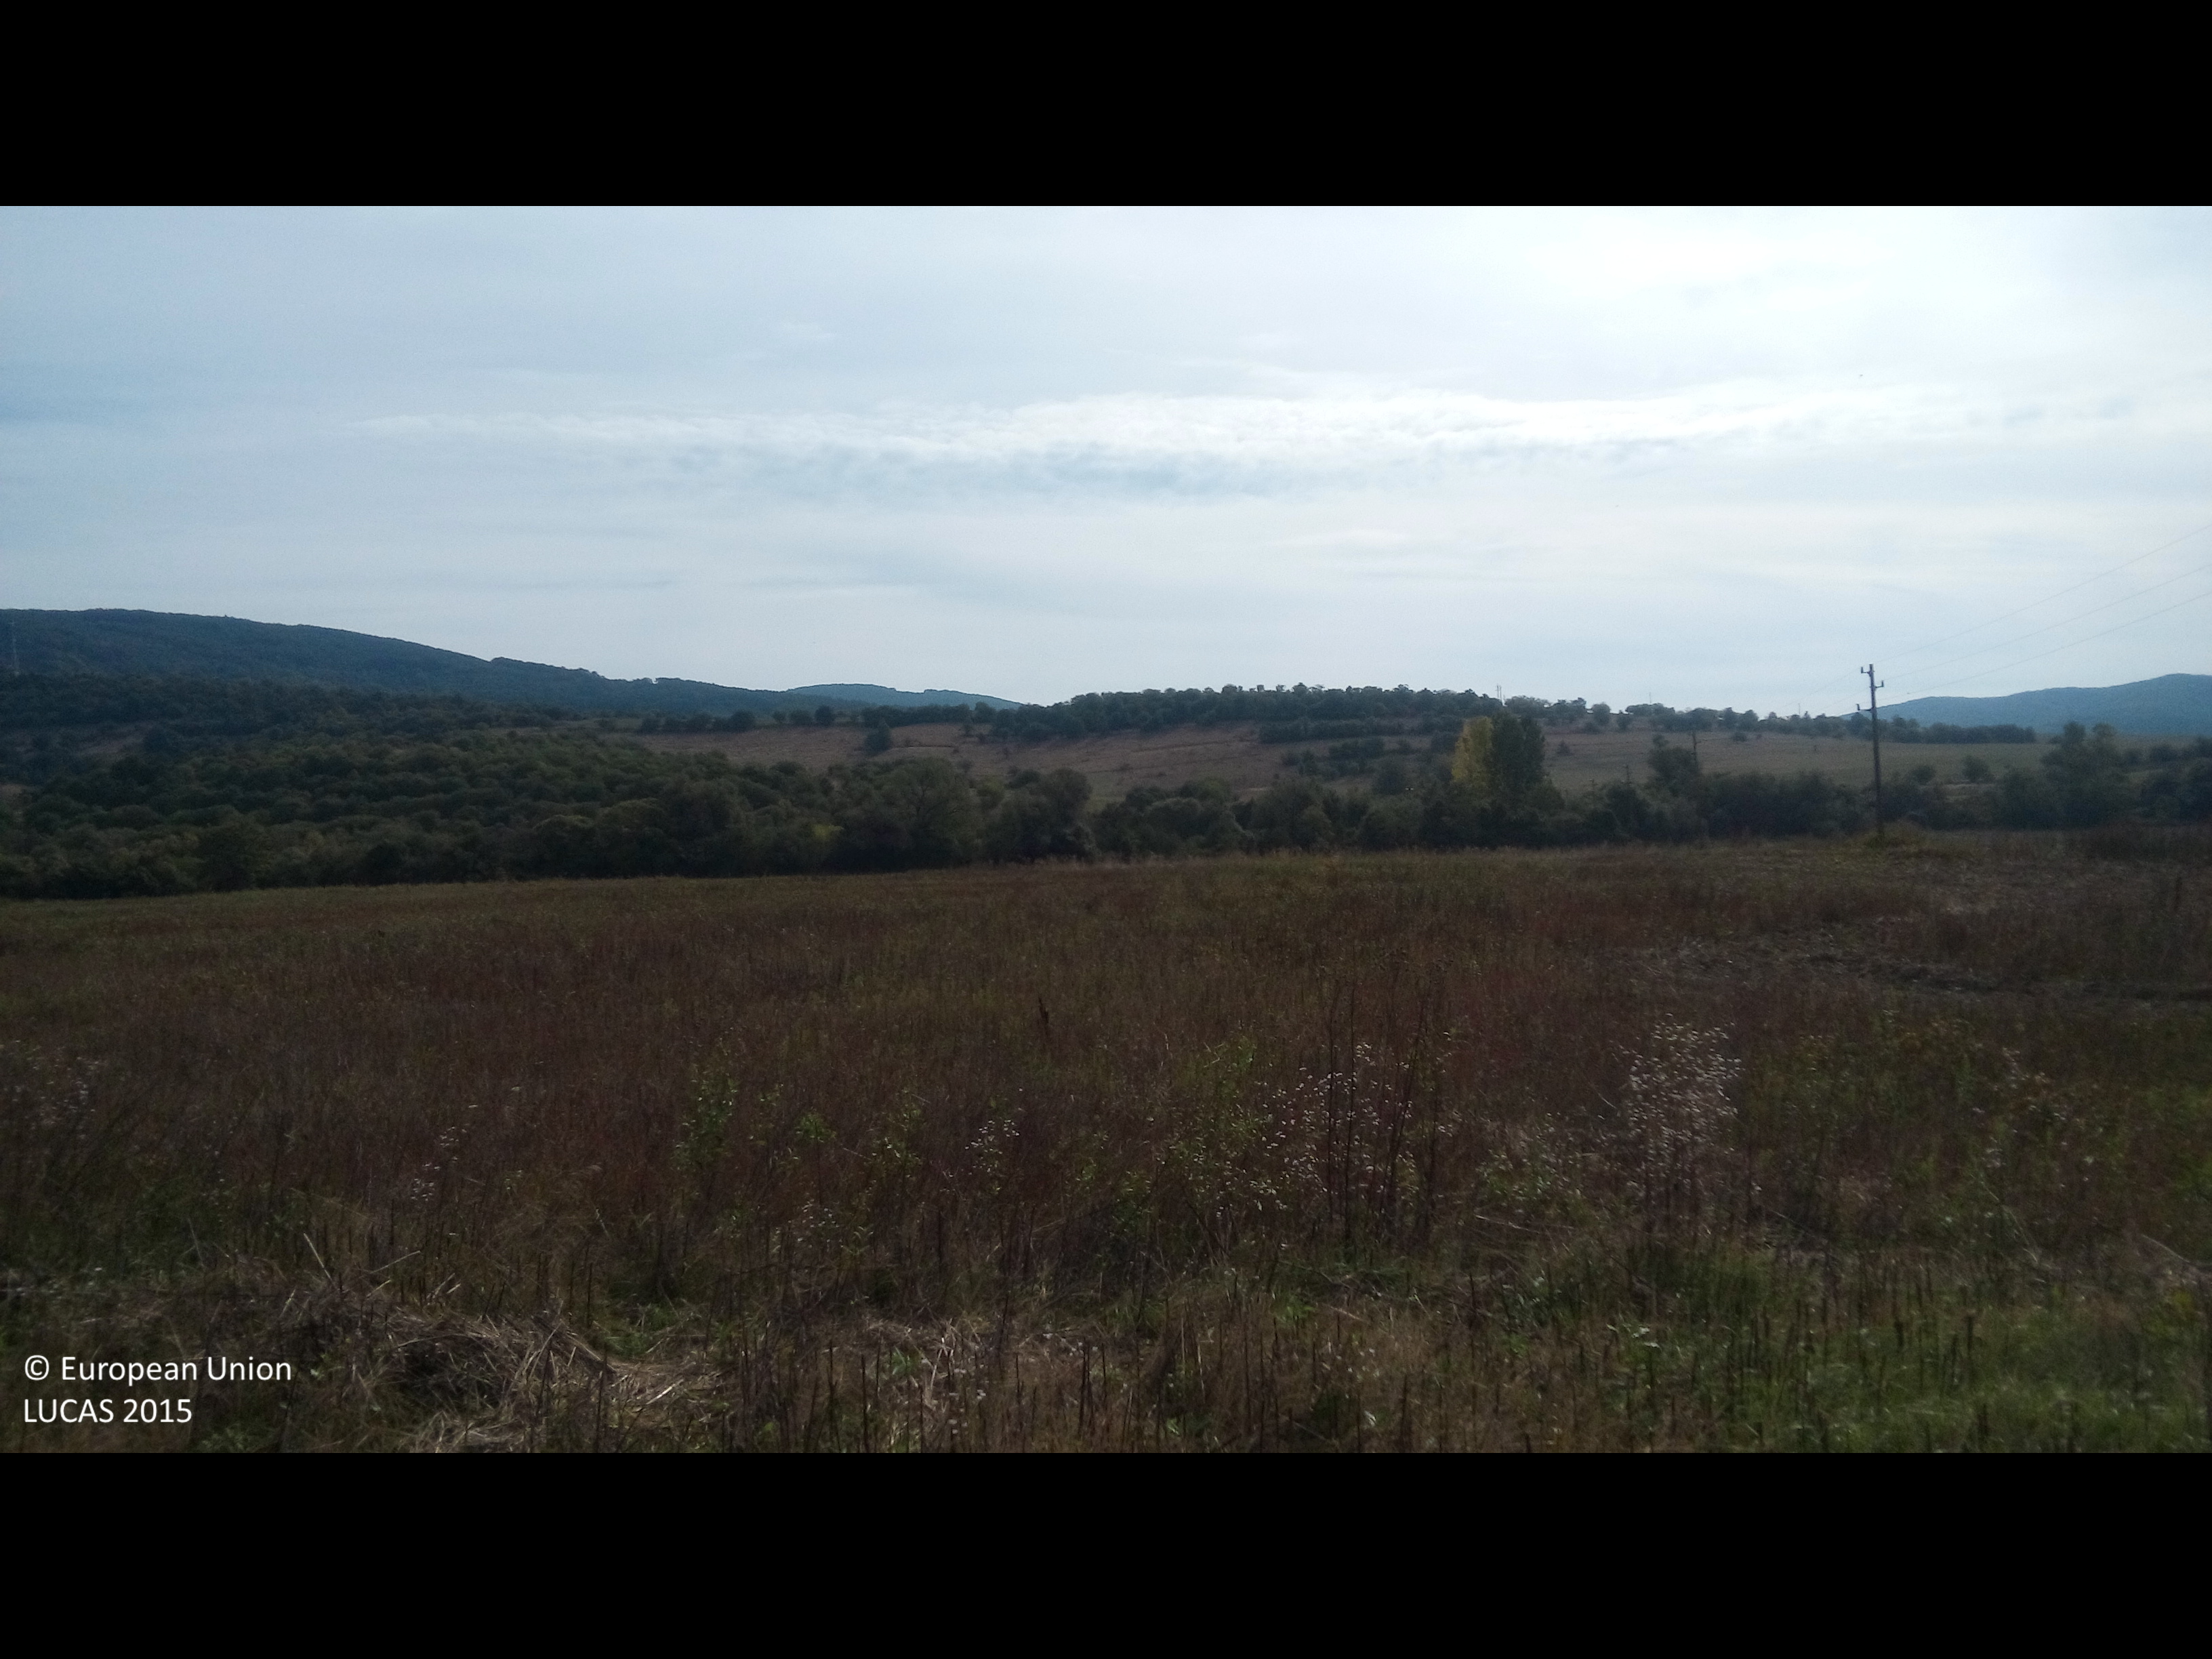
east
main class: Cropland
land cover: Common wheat
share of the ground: 50 - 75 %
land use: Agriculture (excluding fallow land and kitchen gardens)
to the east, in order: Common wheat; Spontaneously vegetated surfaces; Common wheat; Tracks; Common wheat; Other bare soil
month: October
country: BG
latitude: 42.7390
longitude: 23.8582
